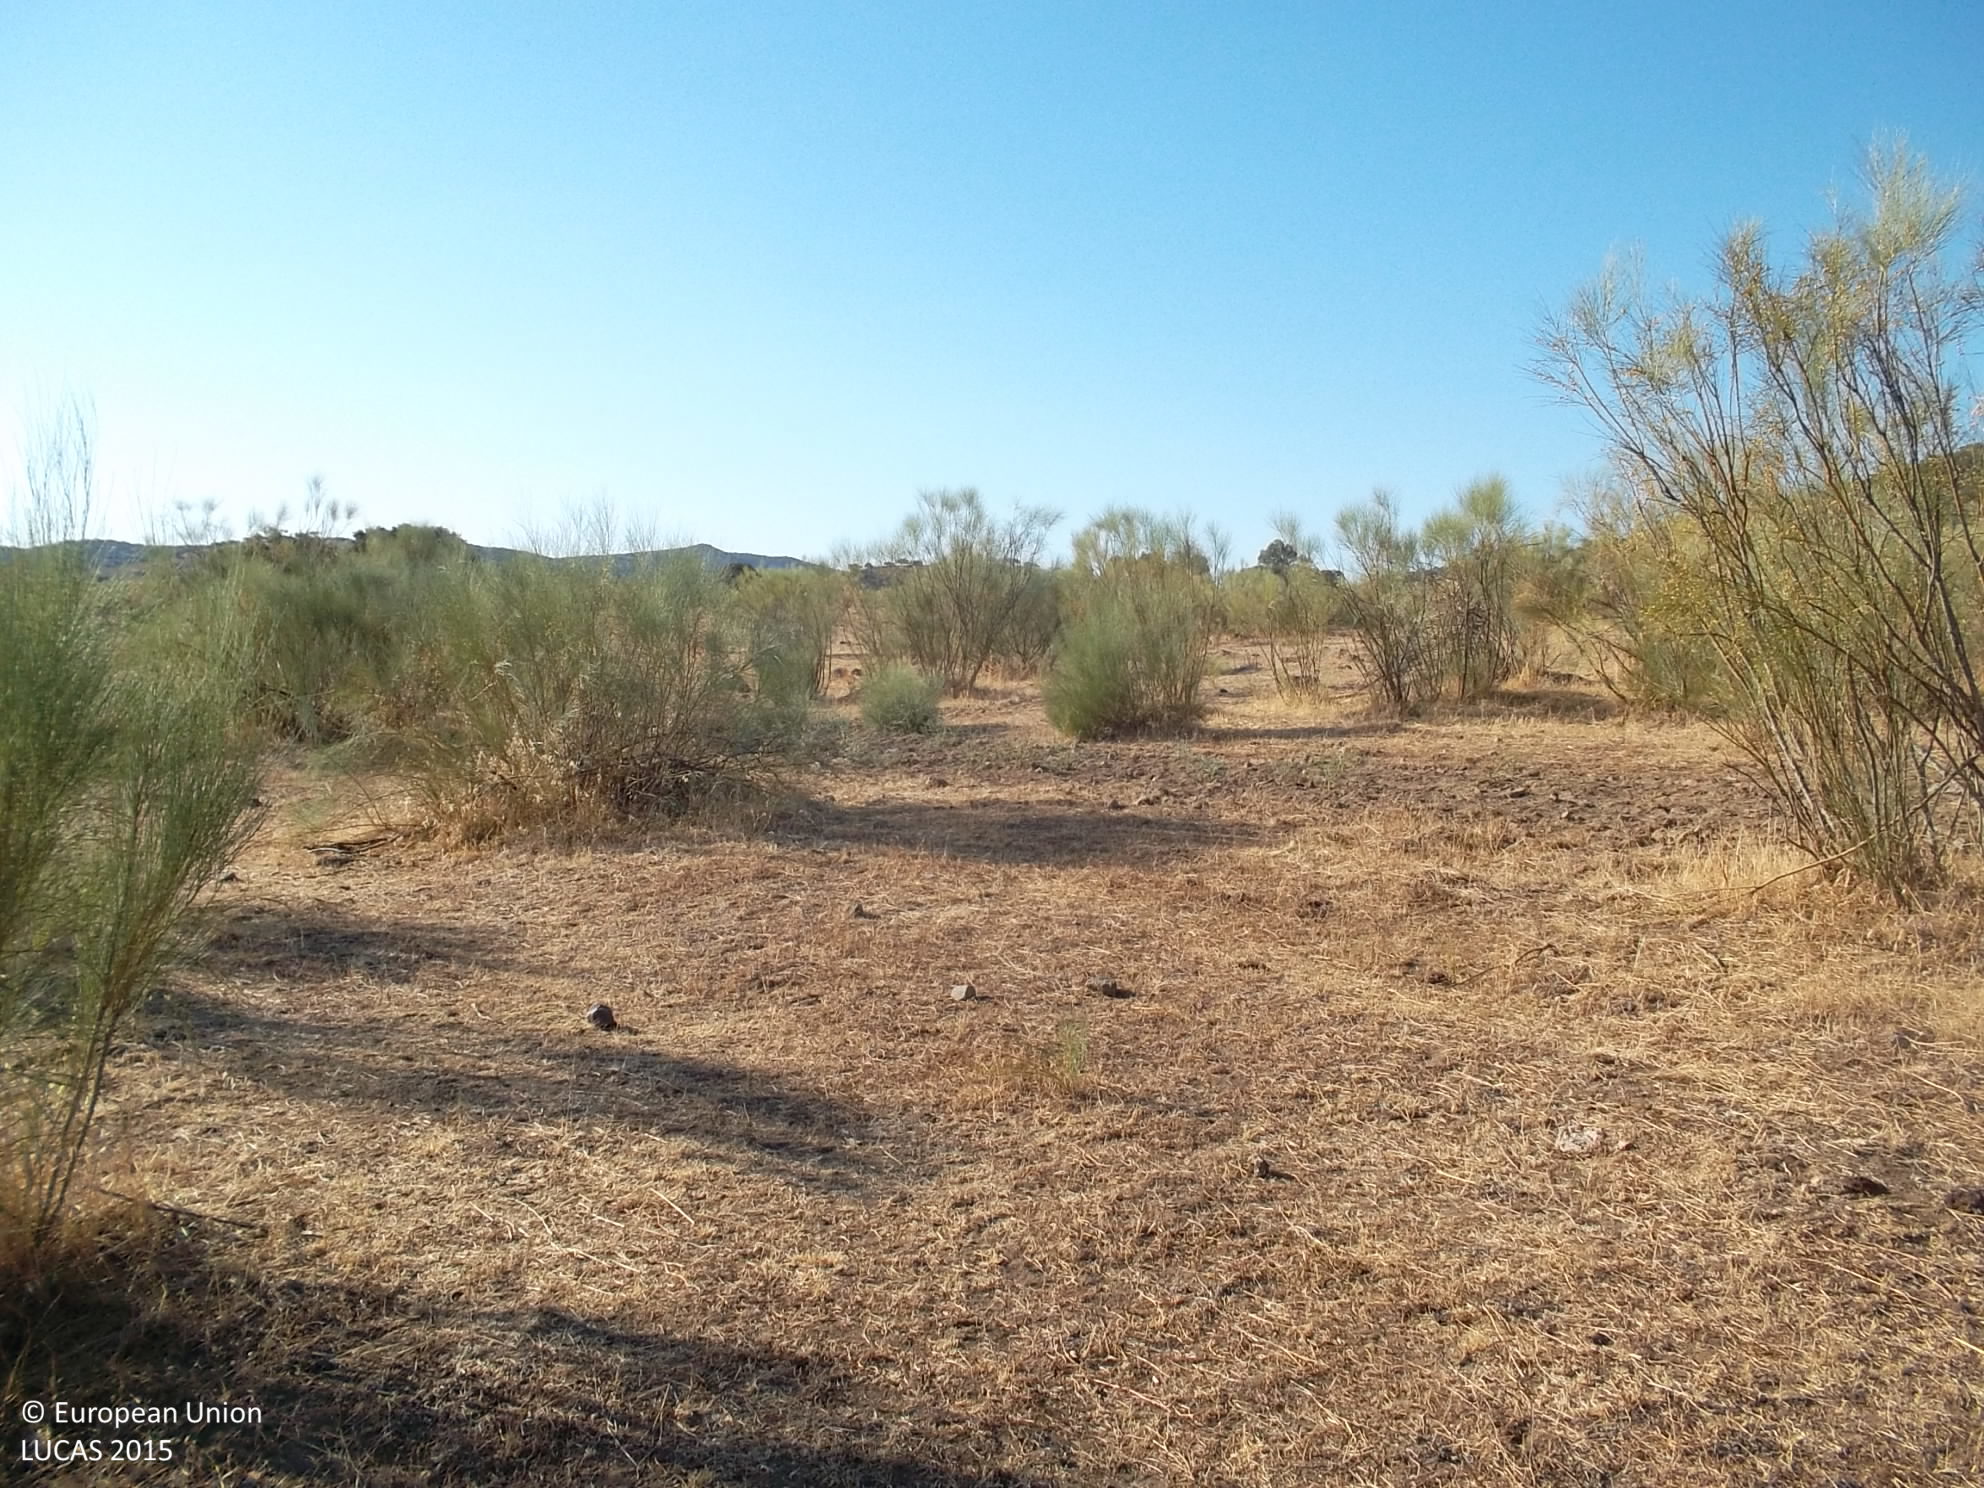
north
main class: Shrubland
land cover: Shrubland with sparse tree cover
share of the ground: > 75 %
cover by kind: herbaceous plants 75 %, shrubs 20 %, broadleaved forest trees 5 %
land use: Agriculture (excluding fallow land and kitchen gardens)
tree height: < 5 m
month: August
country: ES
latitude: 38.3663
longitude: -6.6844
